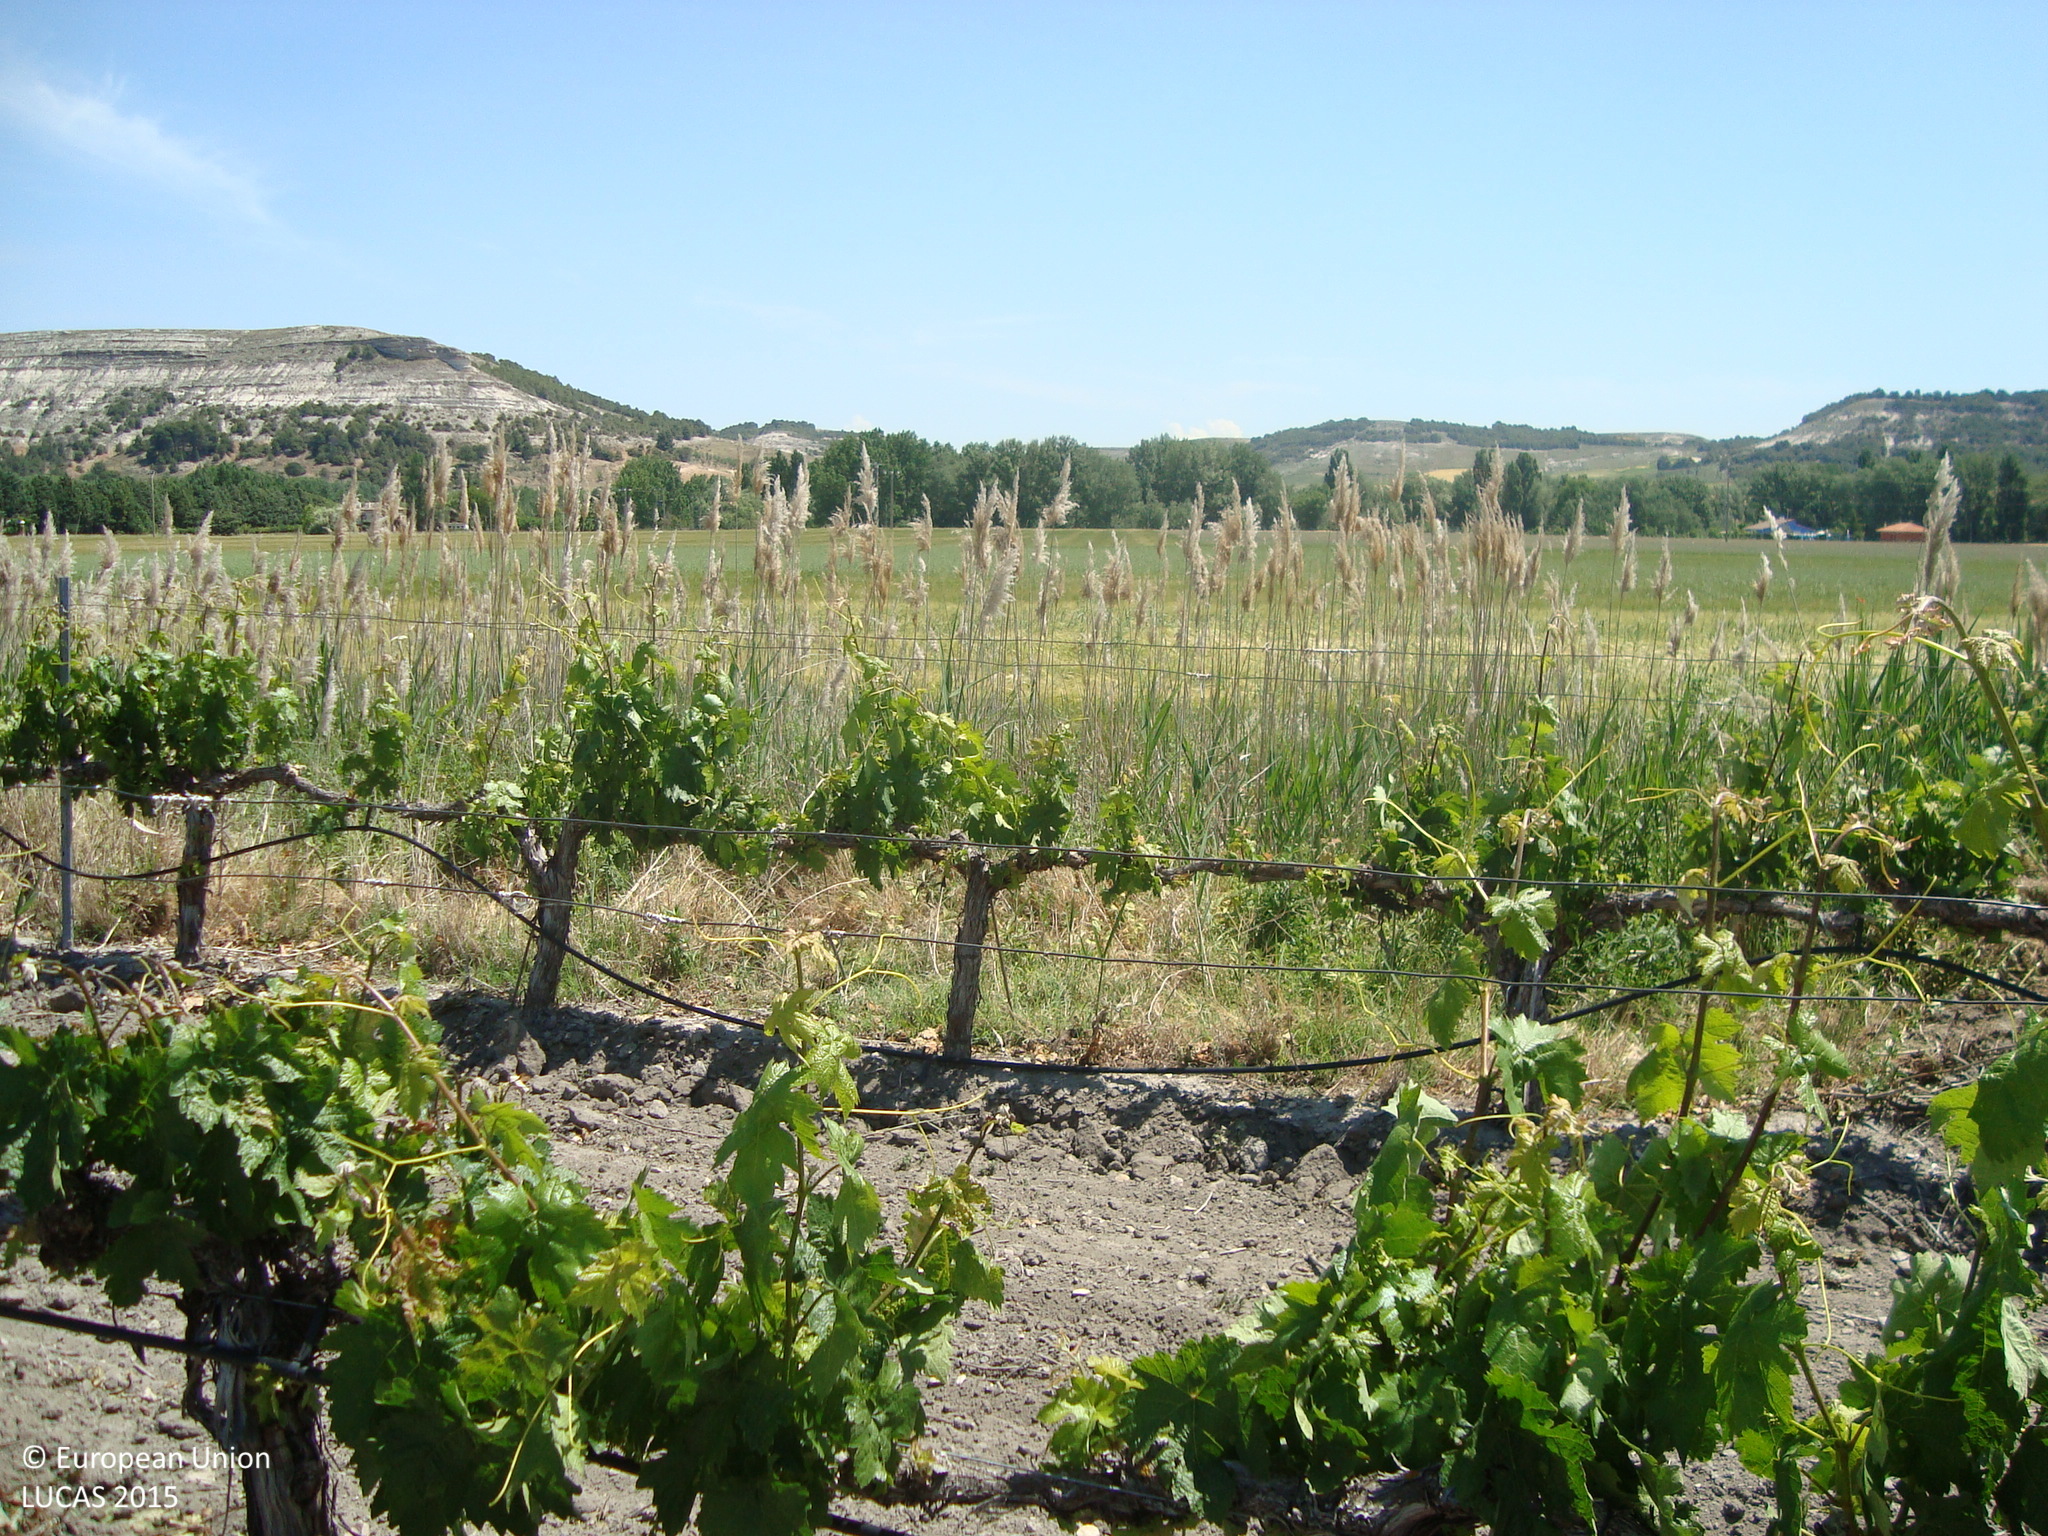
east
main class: Cropland
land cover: Vineyards
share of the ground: 10 - 25 %
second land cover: Other bare soil
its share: > 75 %
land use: Agriculture (excluding fallow land and kitchen gardens)
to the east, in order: Vineyards; Other bare soil; Shruby margins; Ditches and canals; Grass margins; Barley; Grass margins; Common wheat
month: May
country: ES
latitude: 41.5670
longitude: -4.1246
